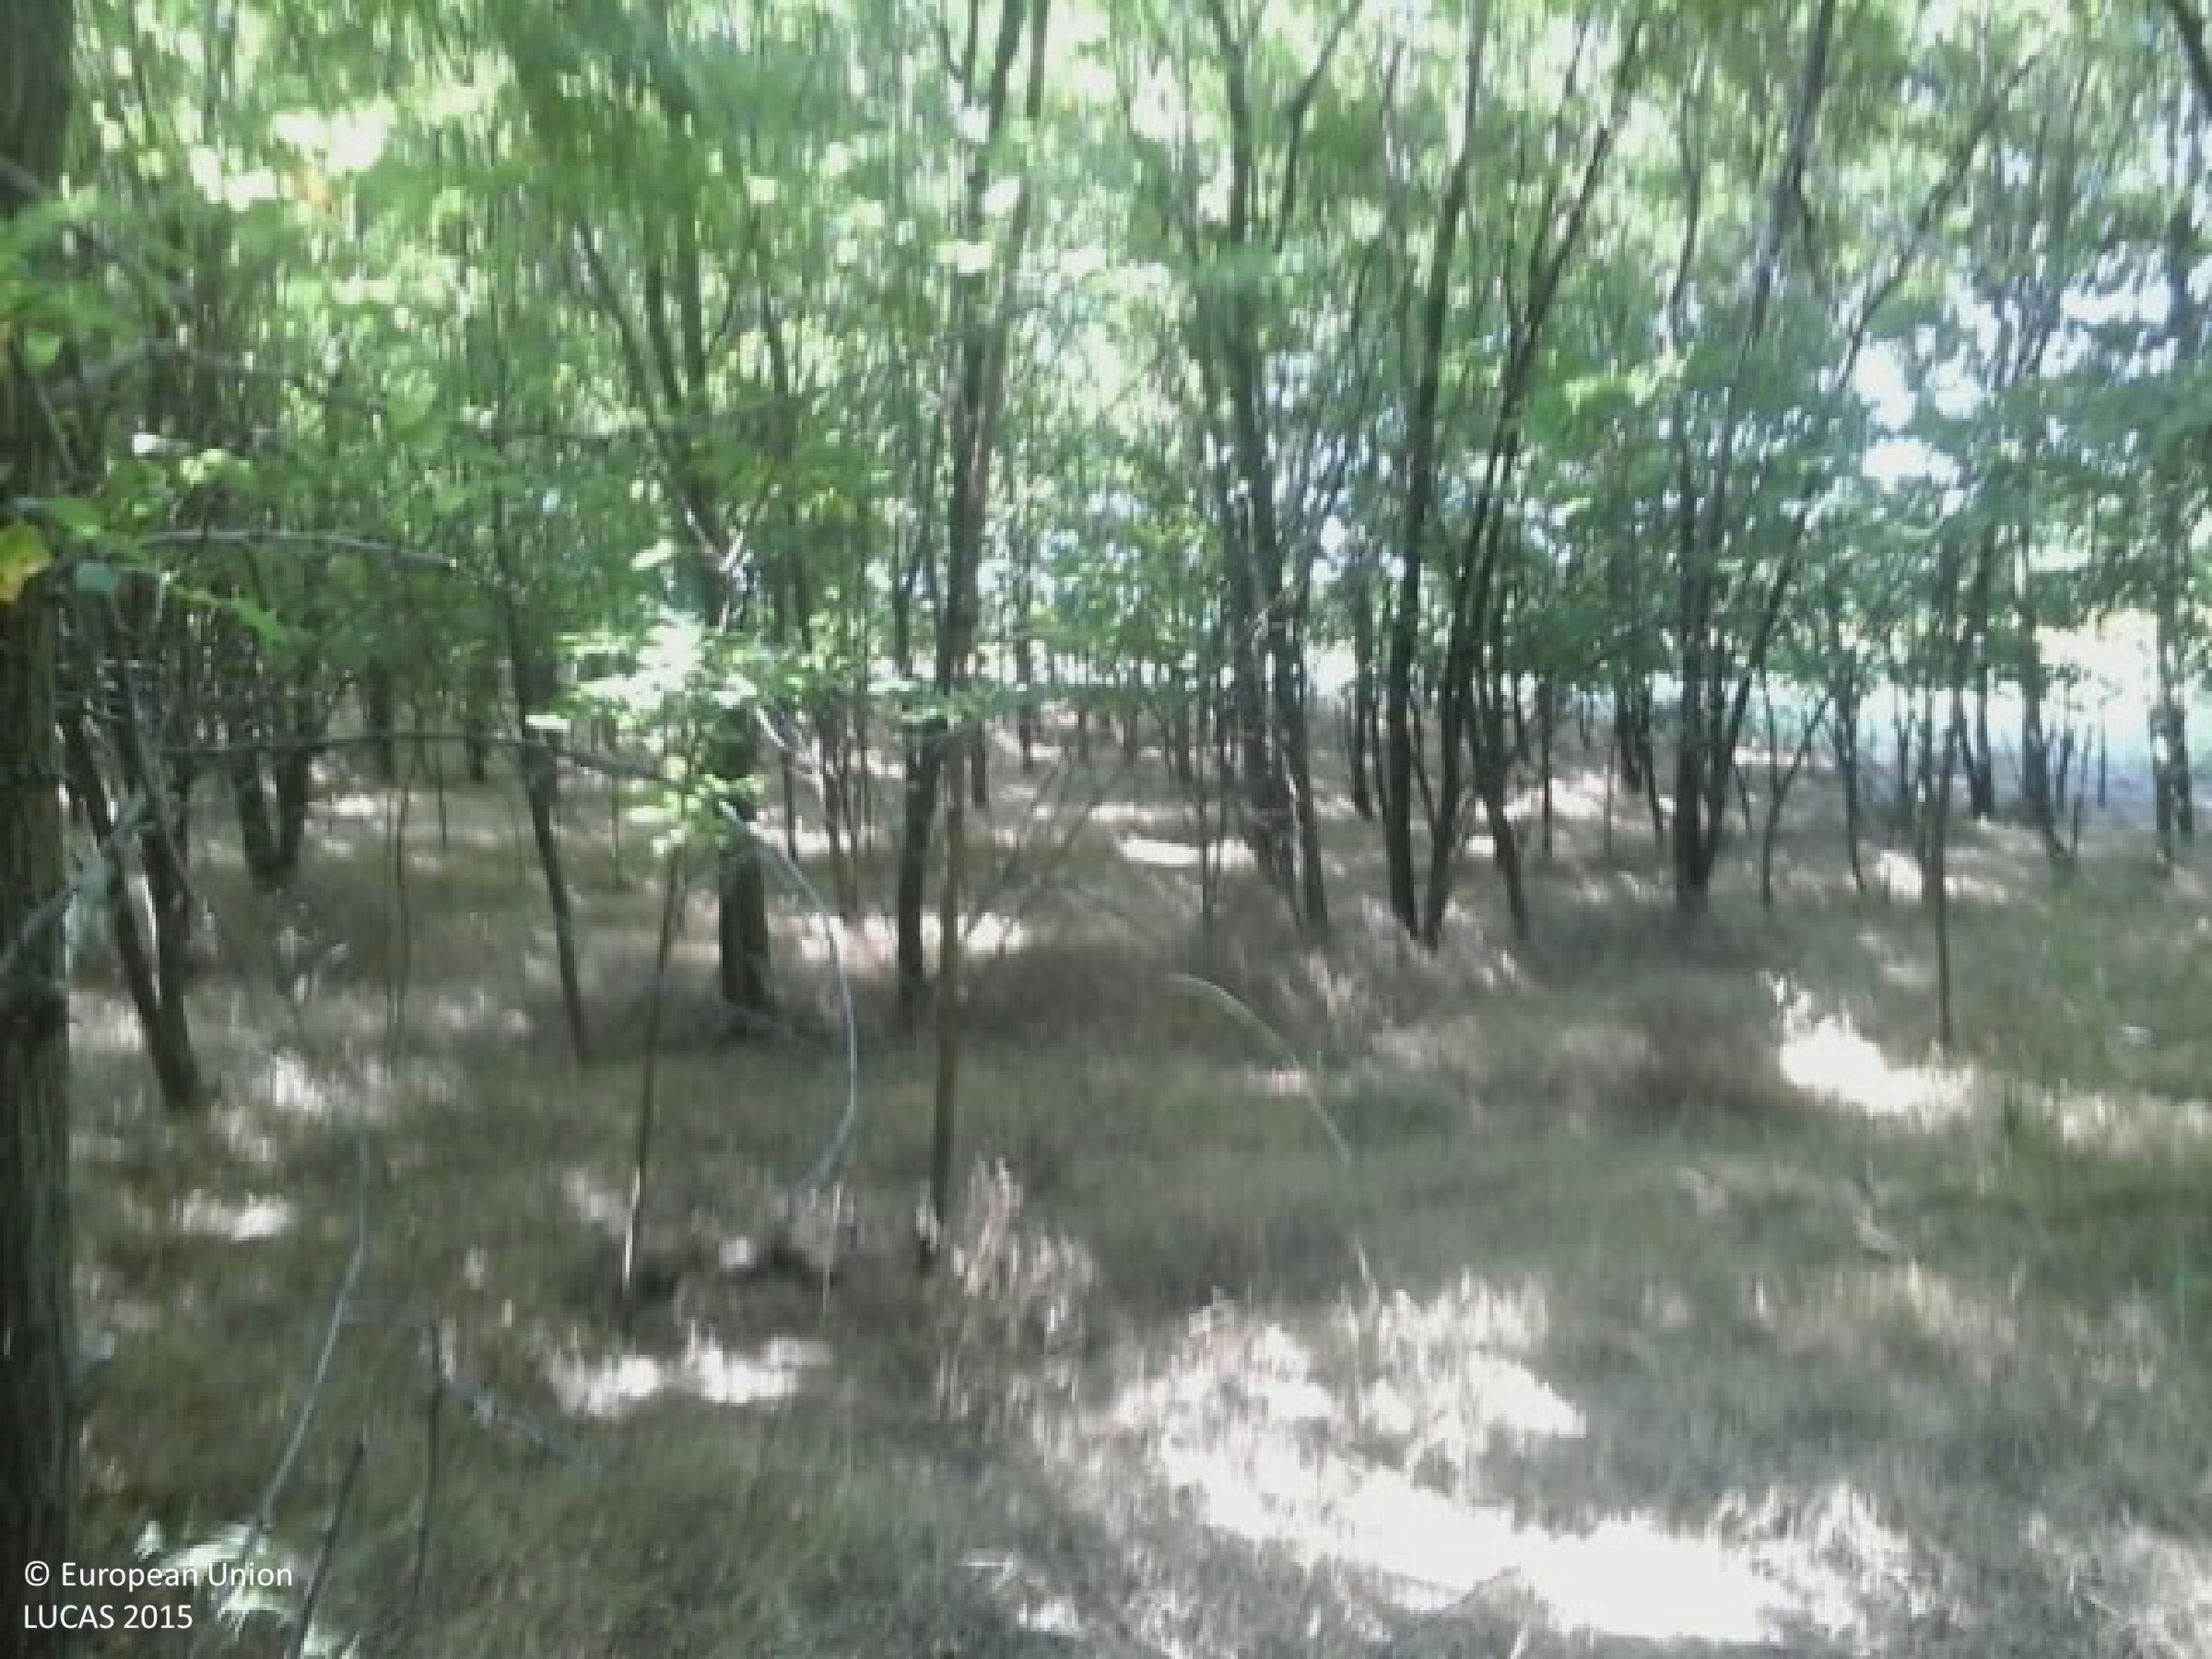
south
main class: Woodland
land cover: Broadleaved woodland
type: mesophytic deciduous forest
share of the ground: > 75 %
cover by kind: broadleaved forest trees 75 %, herbaceous plants 25 %
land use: Forestry
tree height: > 5 m
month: July
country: HU
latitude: 46.7539
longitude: 18.9556
